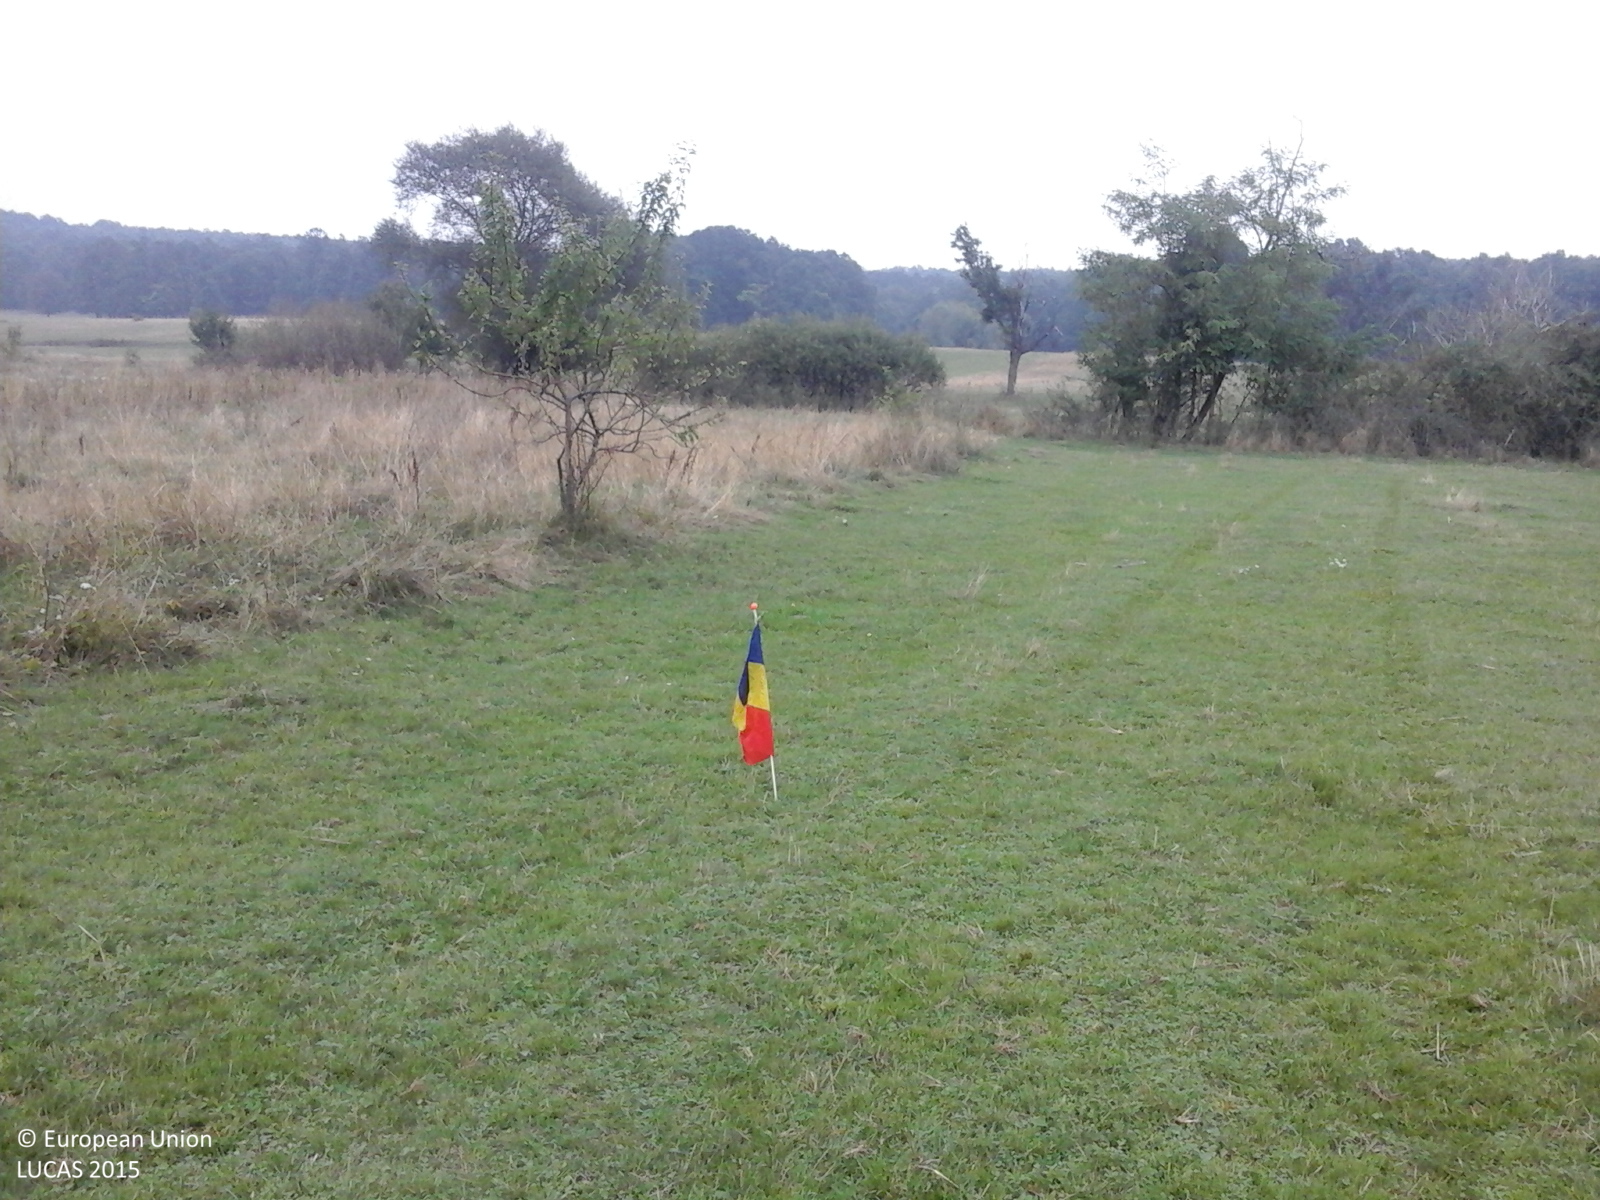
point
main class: Grassland
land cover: Grassland without tree/shrub cover
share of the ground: > 75 %
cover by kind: herbaceous plants 100 %
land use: Agriculture (excluding fallow land and kitchen gardens)
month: September
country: RO
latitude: 45.1373
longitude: 23.2667
